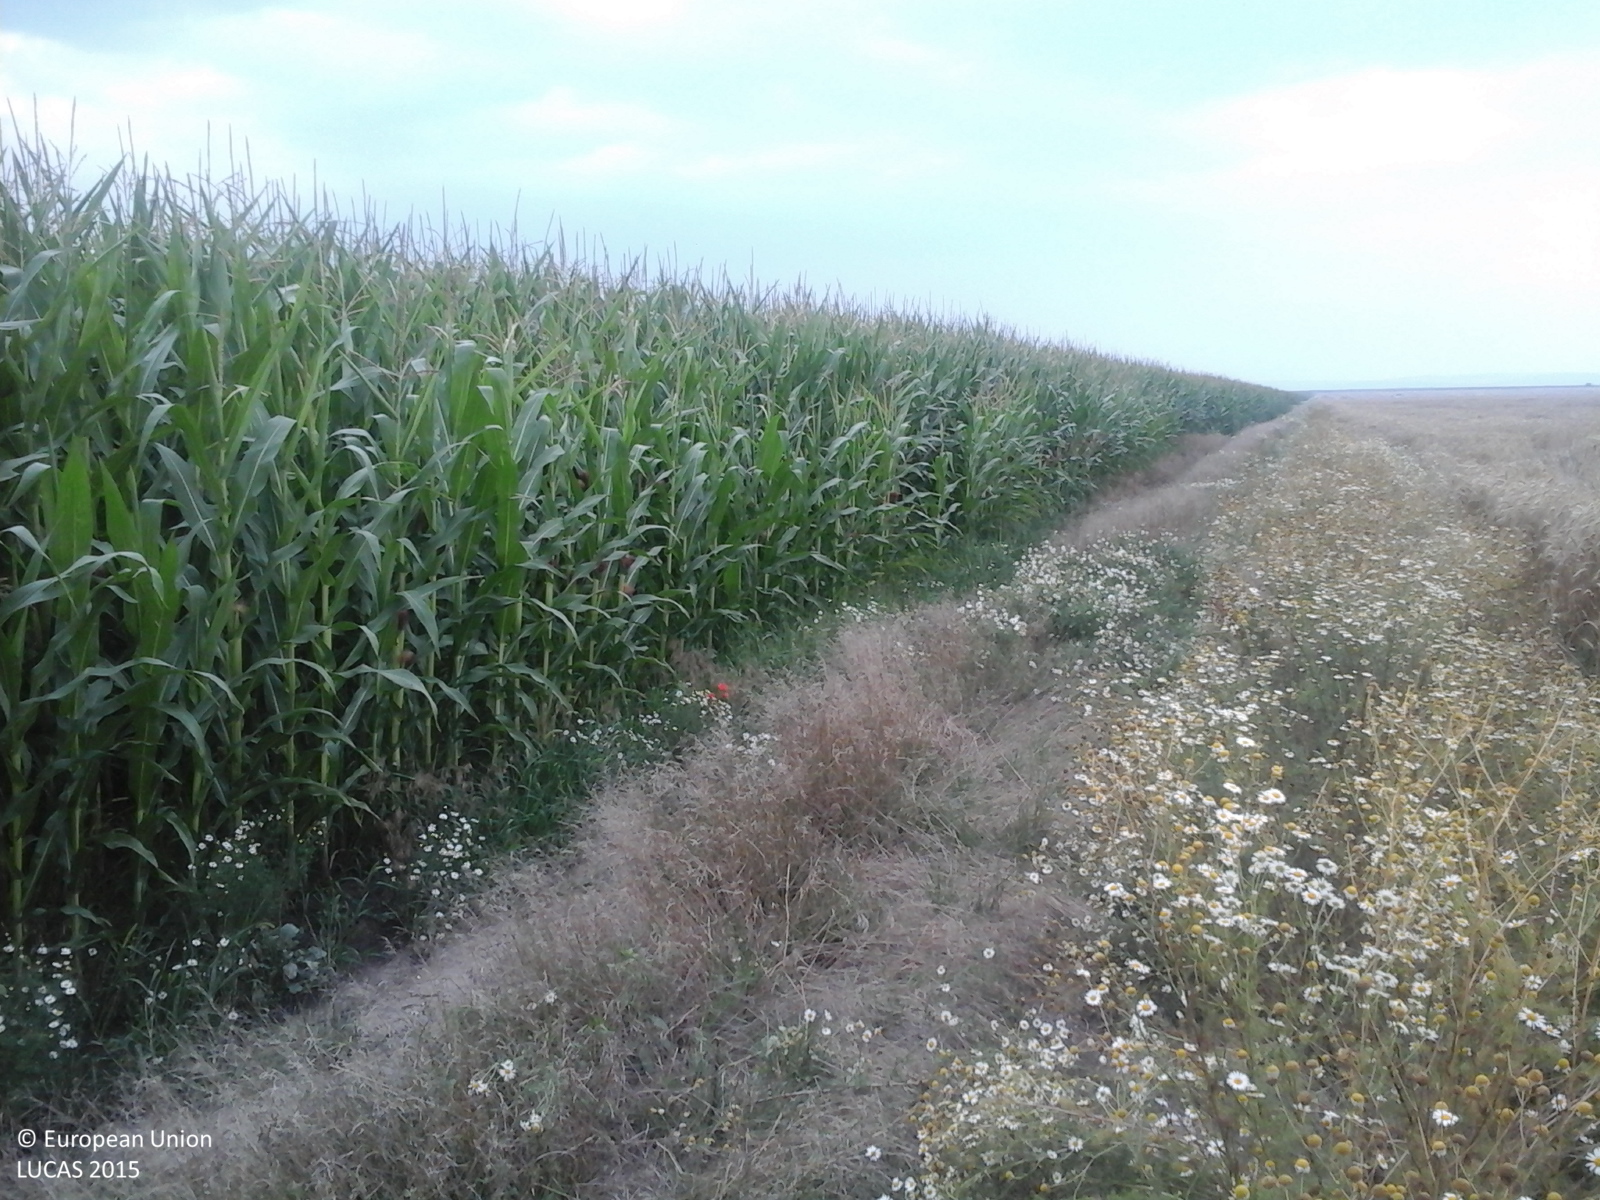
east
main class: Cropland
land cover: Common wheat
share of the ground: > 75 %
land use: Agriculture (excluding fallow land and kitchen gardens)
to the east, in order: Common wheat
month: July
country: RO
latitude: 43.8086
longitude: 25.6899
